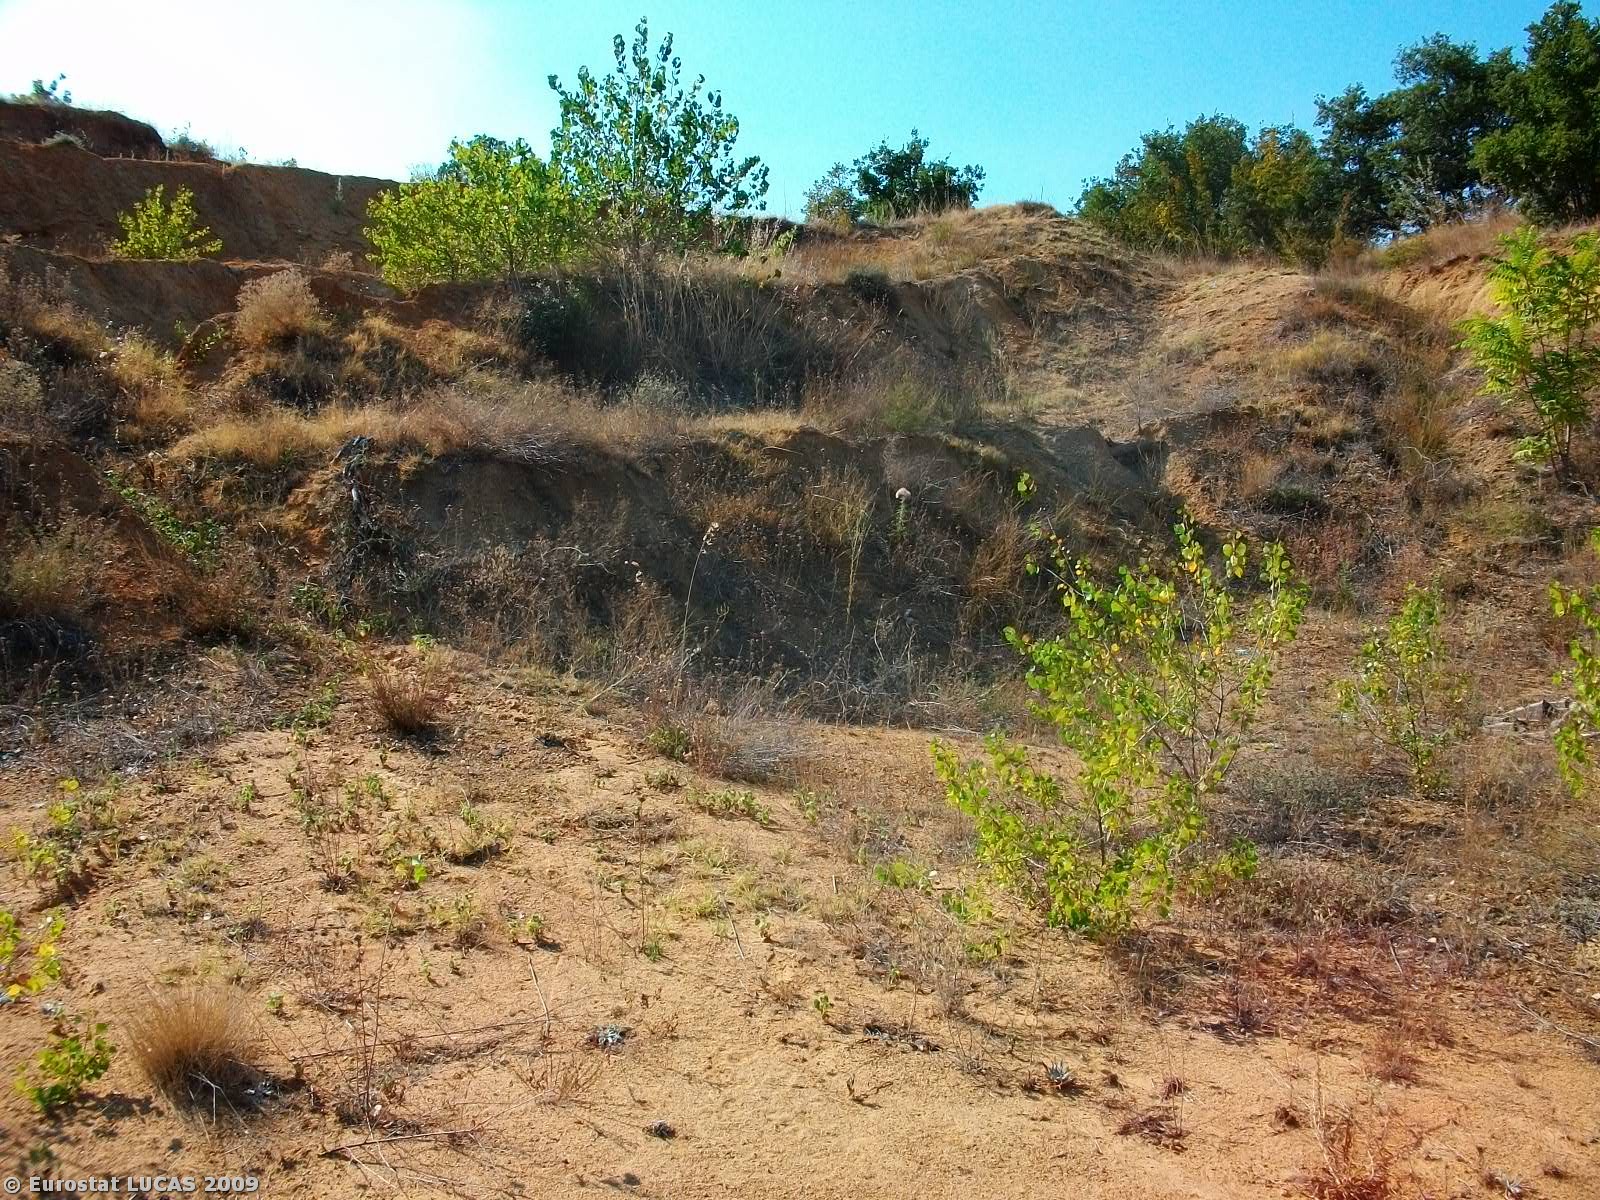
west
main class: Grassland
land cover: Grassland with sparse tree/shrub cover
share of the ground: 10 - 25 %
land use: Unused
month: August
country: GR
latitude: 41.3298
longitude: 26.4808
